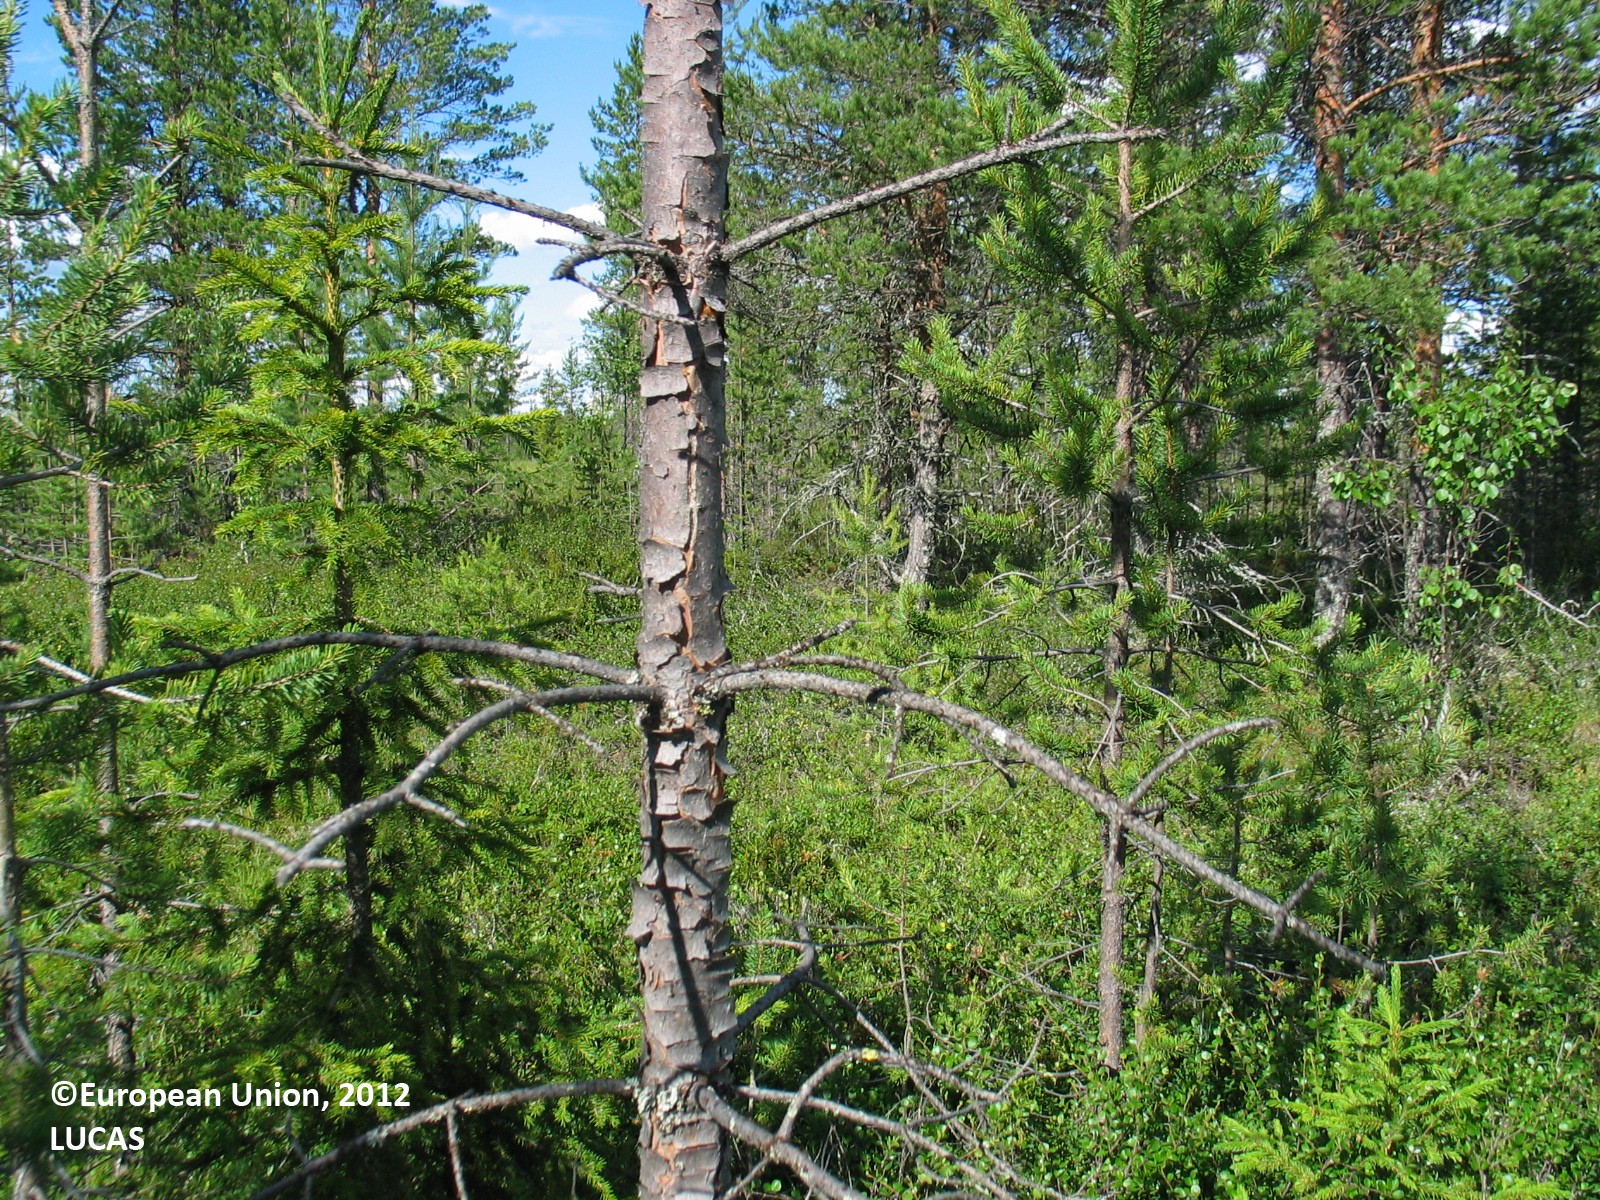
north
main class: Woodland
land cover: Pine dominated coniferous woodland
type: mire and swamp forests
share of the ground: 25 - 50 %
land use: Forestry
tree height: > 5 m
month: July
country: FI
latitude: 65.9213
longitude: 24.9310
